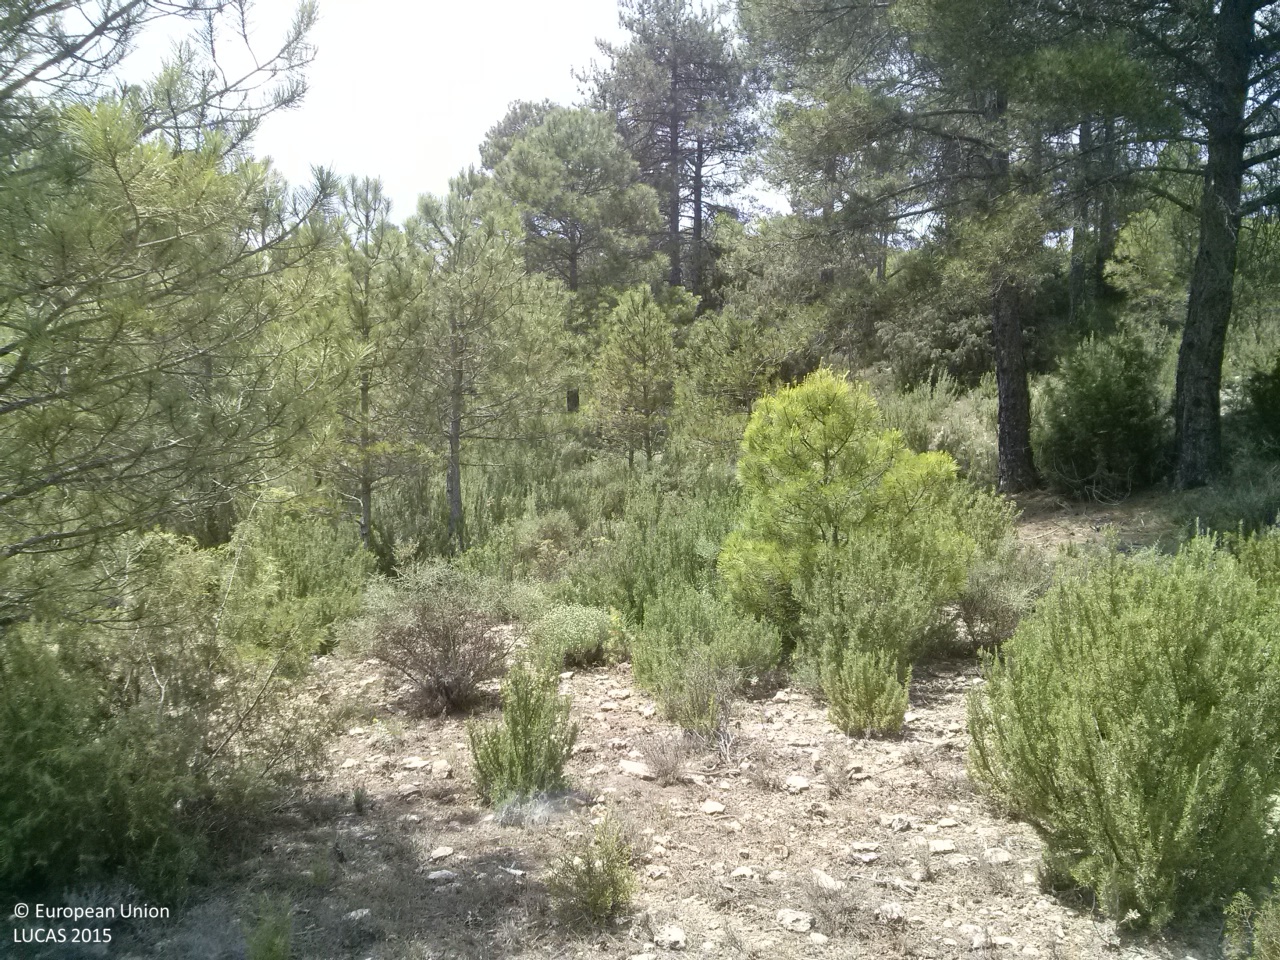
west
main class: Woodland
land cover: Pine dominated coniferous woodland
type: coniferous forest of the mediterranean region
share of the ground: 10 - 25 %
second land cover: Shrubland without tree cover
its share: 25 - 50 %
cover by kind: shrubs 50 %, herbaceous plants 30 %, coniferous forest trees 10 %, unconsolidated bare surface 10 %
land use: Forestry
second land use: Agriculture (excluding fallow land and kitchen gardens)
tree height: > 5 m
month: June
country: ES
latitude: 39.8474
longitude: -1.7793
